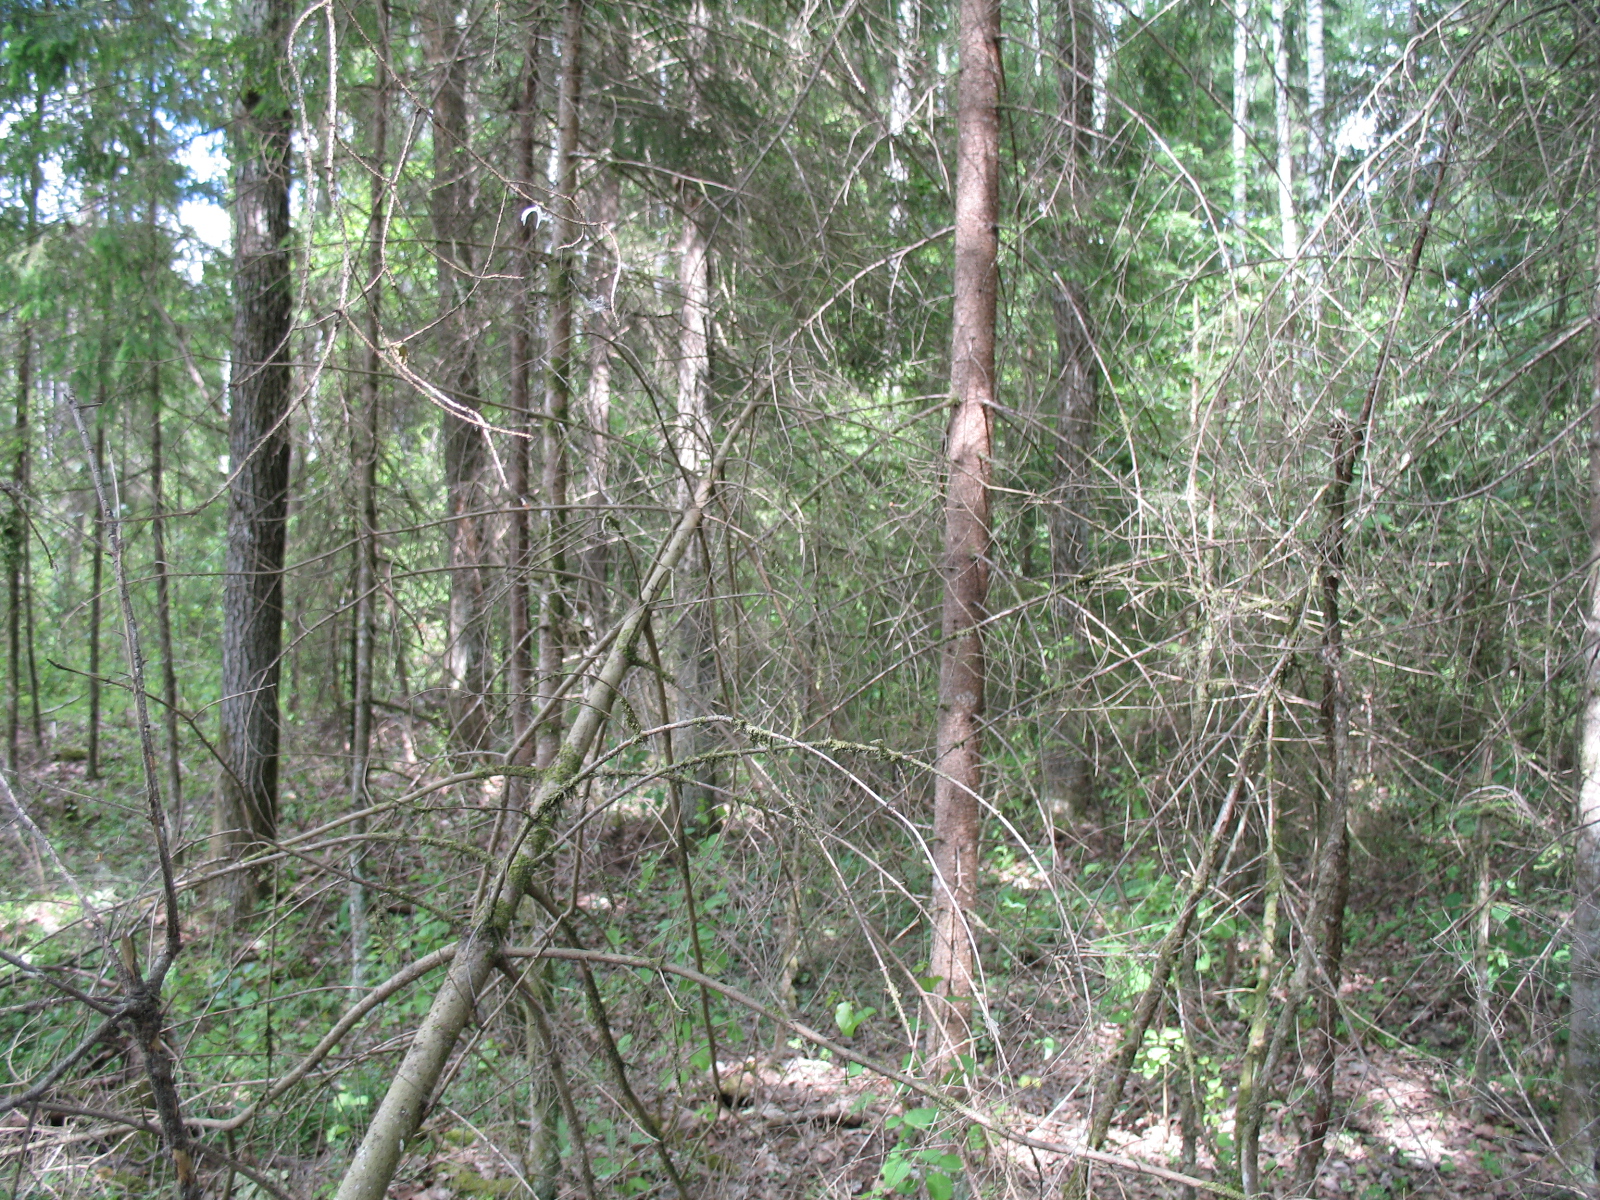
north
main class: Woodland
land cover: Spruce dominated mixed woodland
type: hemiboreal forest and nemoral coniferous forest and mixed broadleaved-coniferous forest
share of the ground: > 75 %
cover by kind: broadleaved forest trees 60 %, coniferous forest trees 35 %, shrubs 5 %
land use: Forestry
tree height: > 5 m
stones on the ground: < 10 %
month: June
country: LV
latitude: 56.6746
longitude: 23.5062
